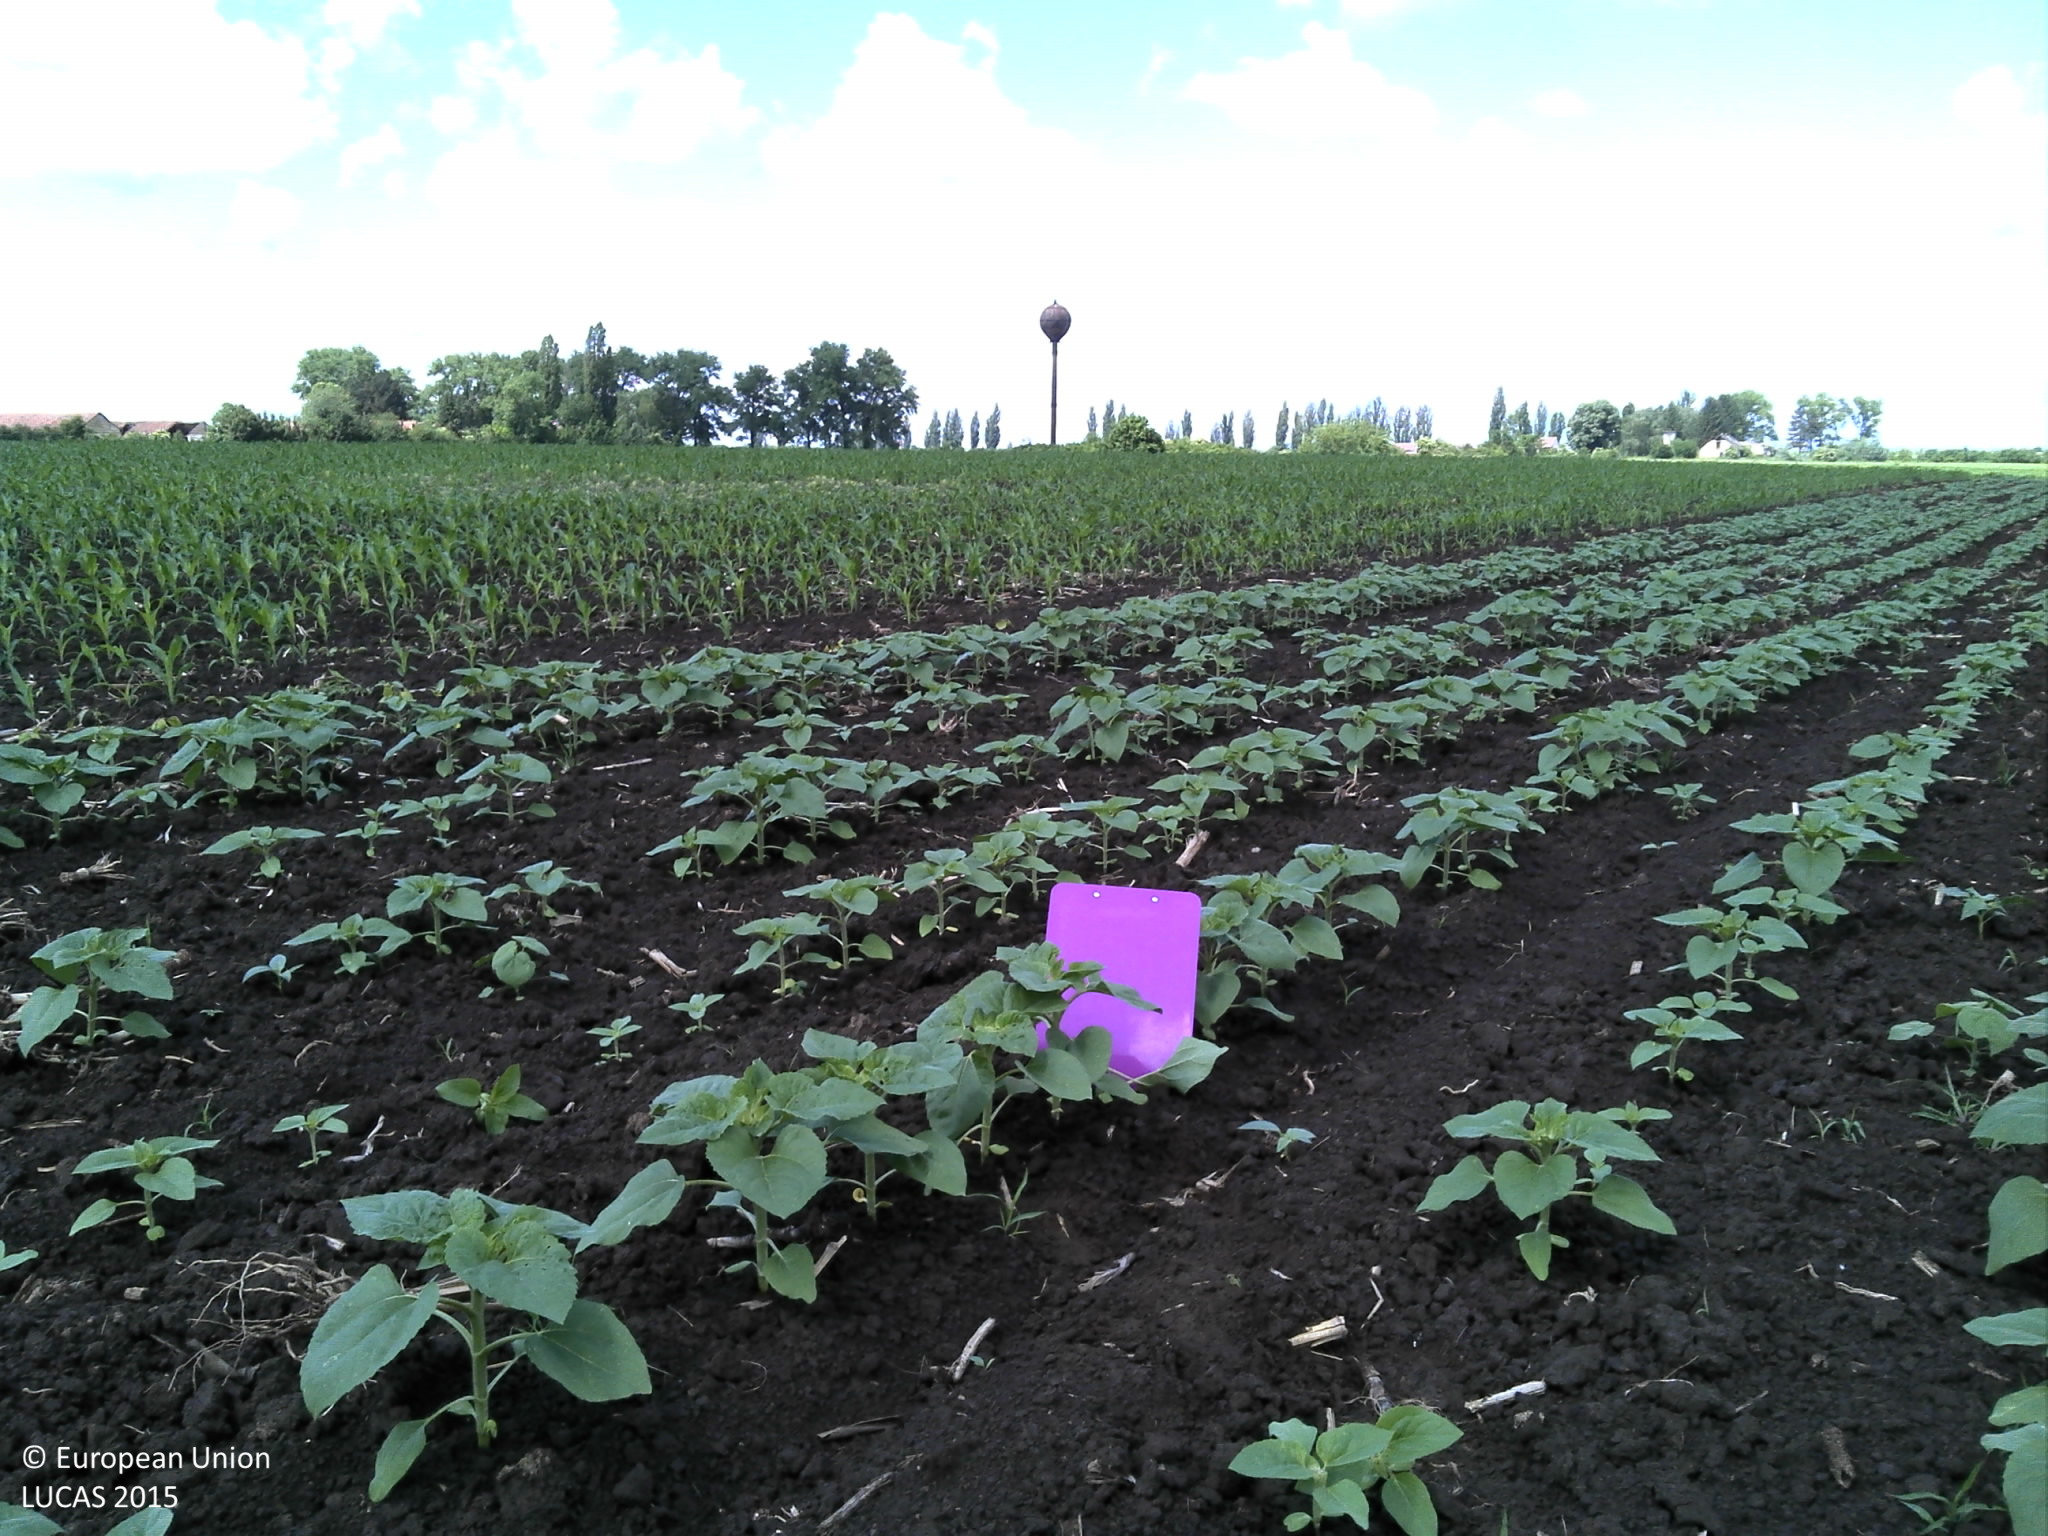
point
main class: Cropland
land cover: Sunflower
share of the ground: 10 - 25 %
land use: Agriculture (excluding fallow land and kitchen gardens)
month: May
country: HR
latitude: 45.5060
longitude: 18.9299
